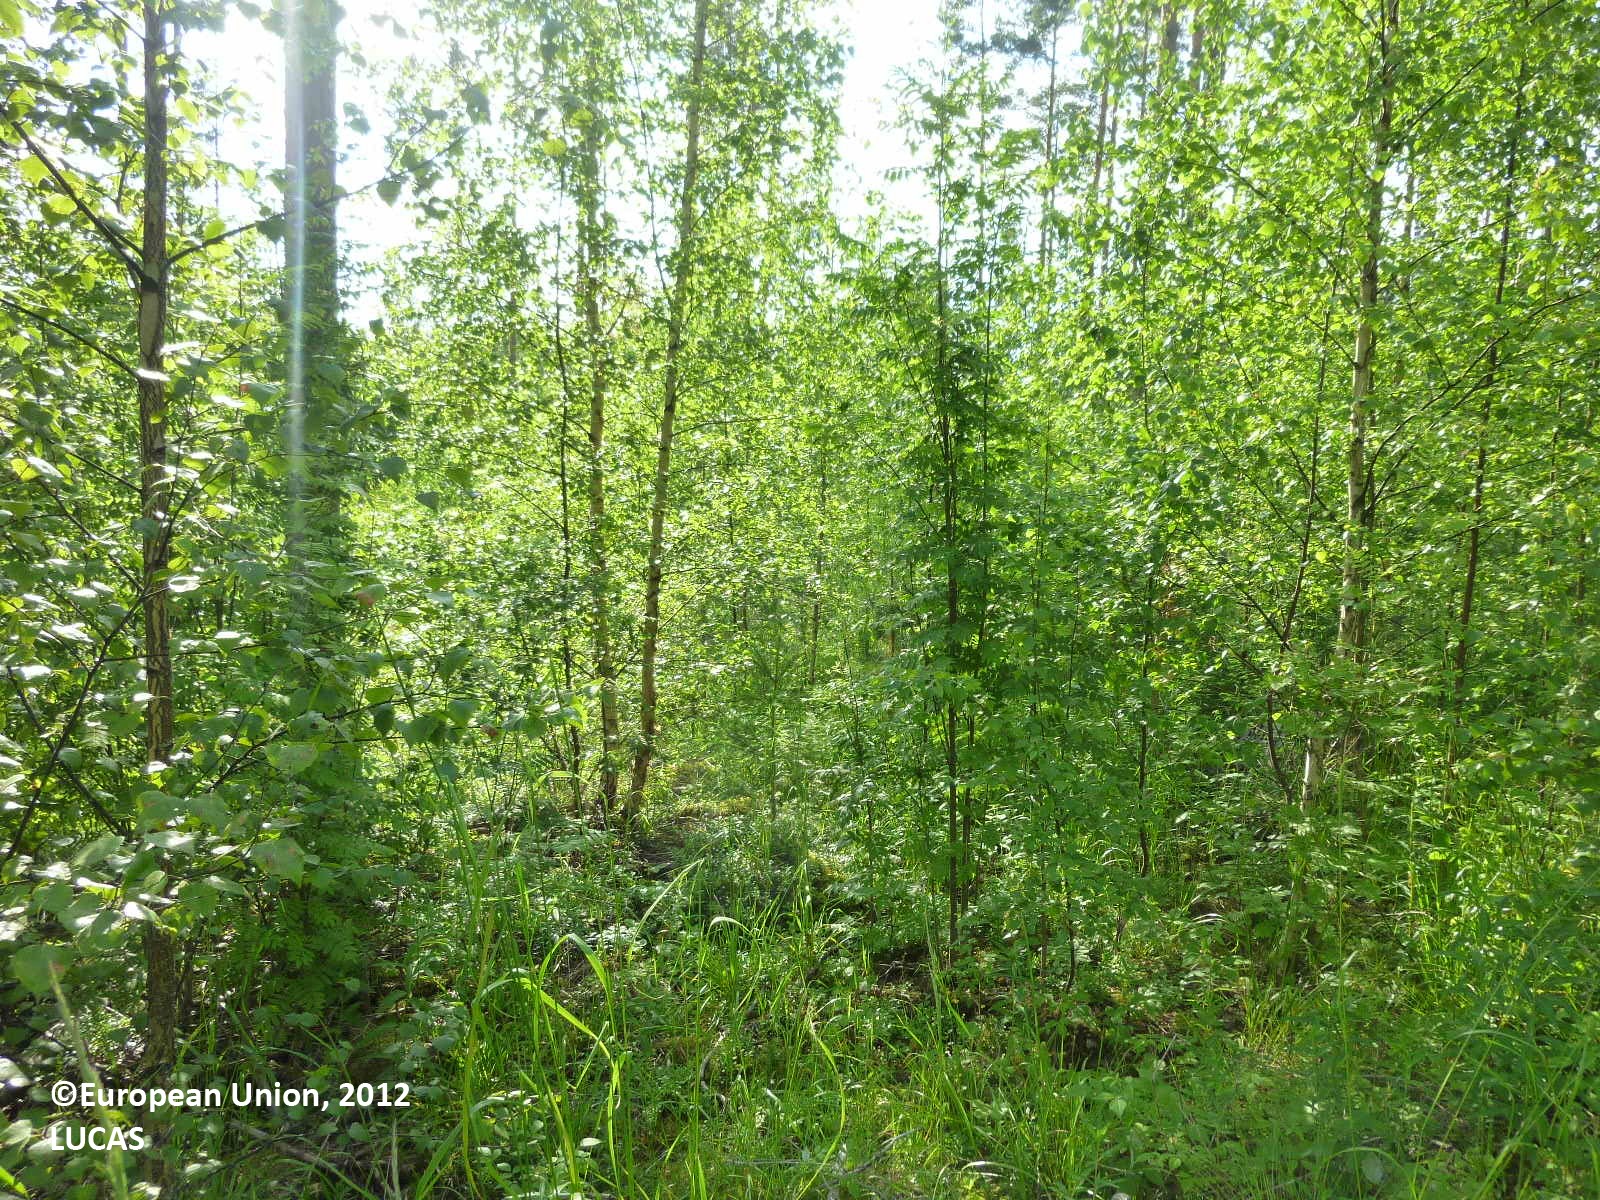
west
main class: Woodland
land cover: Pine dominated mixed woodland
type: boreal forest
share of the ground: 50 - 75 %
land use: Forestry
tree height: > 5 m
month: July
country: FI
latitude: 61.3878
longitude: 22.3609
